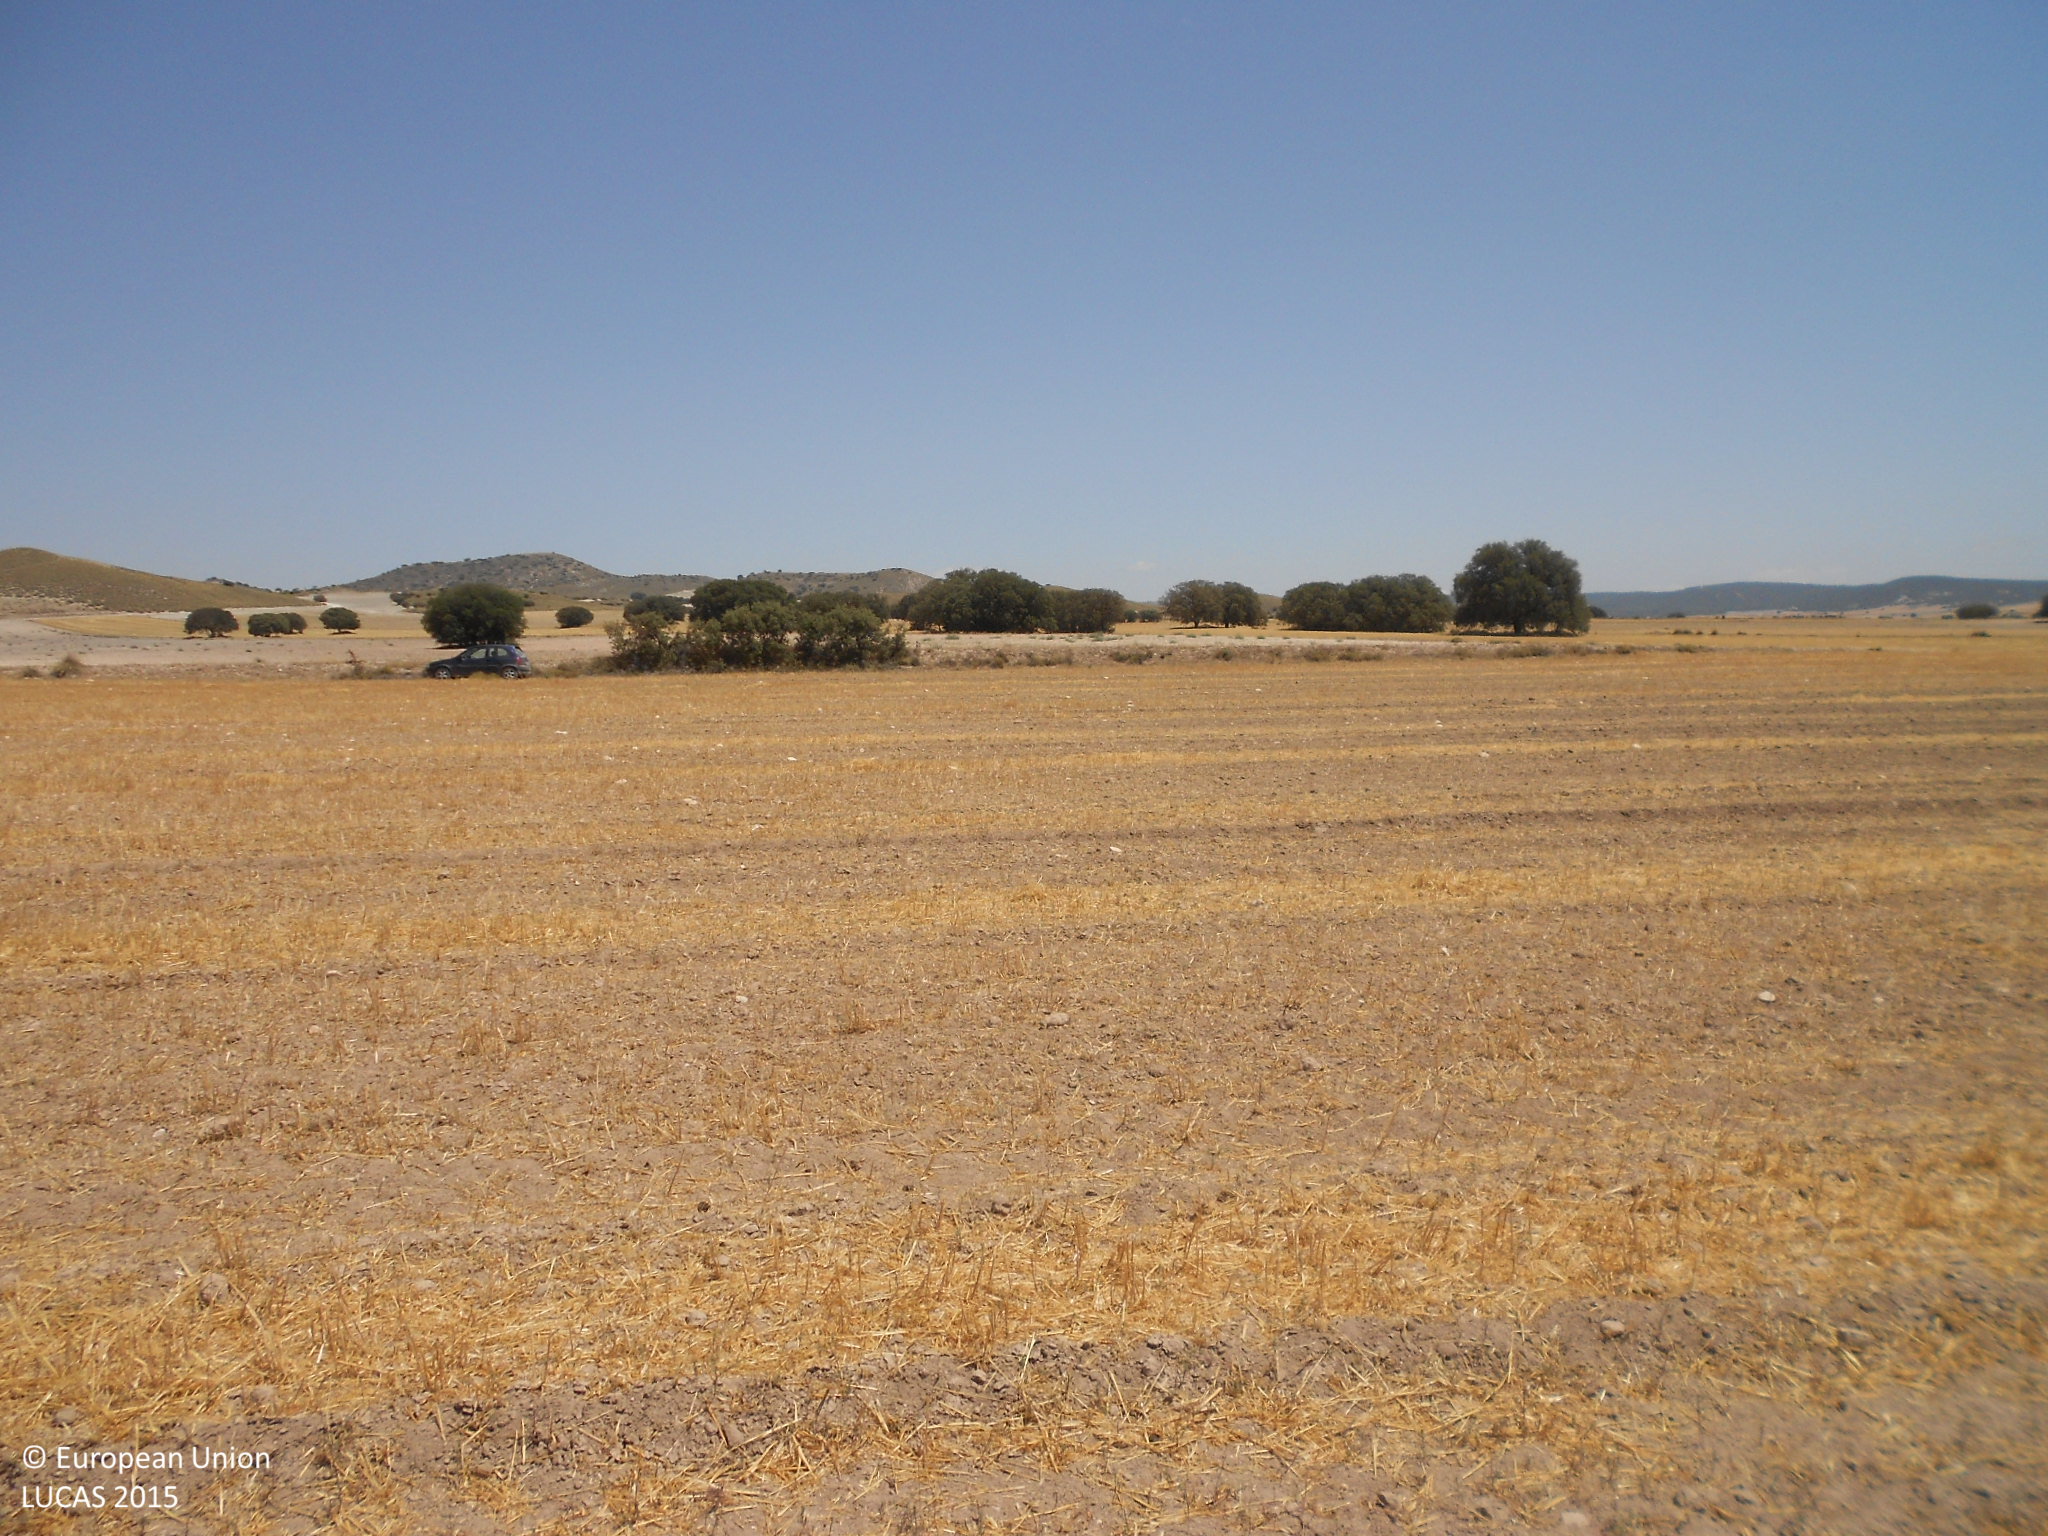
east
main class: Cropland
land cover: Oats
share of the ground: < 10 %
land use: Agriculture (excluding fallow land and kitchen gardens)
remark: Harvested field
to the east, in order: Oats; Tracks; Grass margins; Other bare soil; Grass margins; Common wheat; Broadleaved woodland; Common wheat
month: August
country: ES
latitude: 37.7308
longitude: -2.3209
